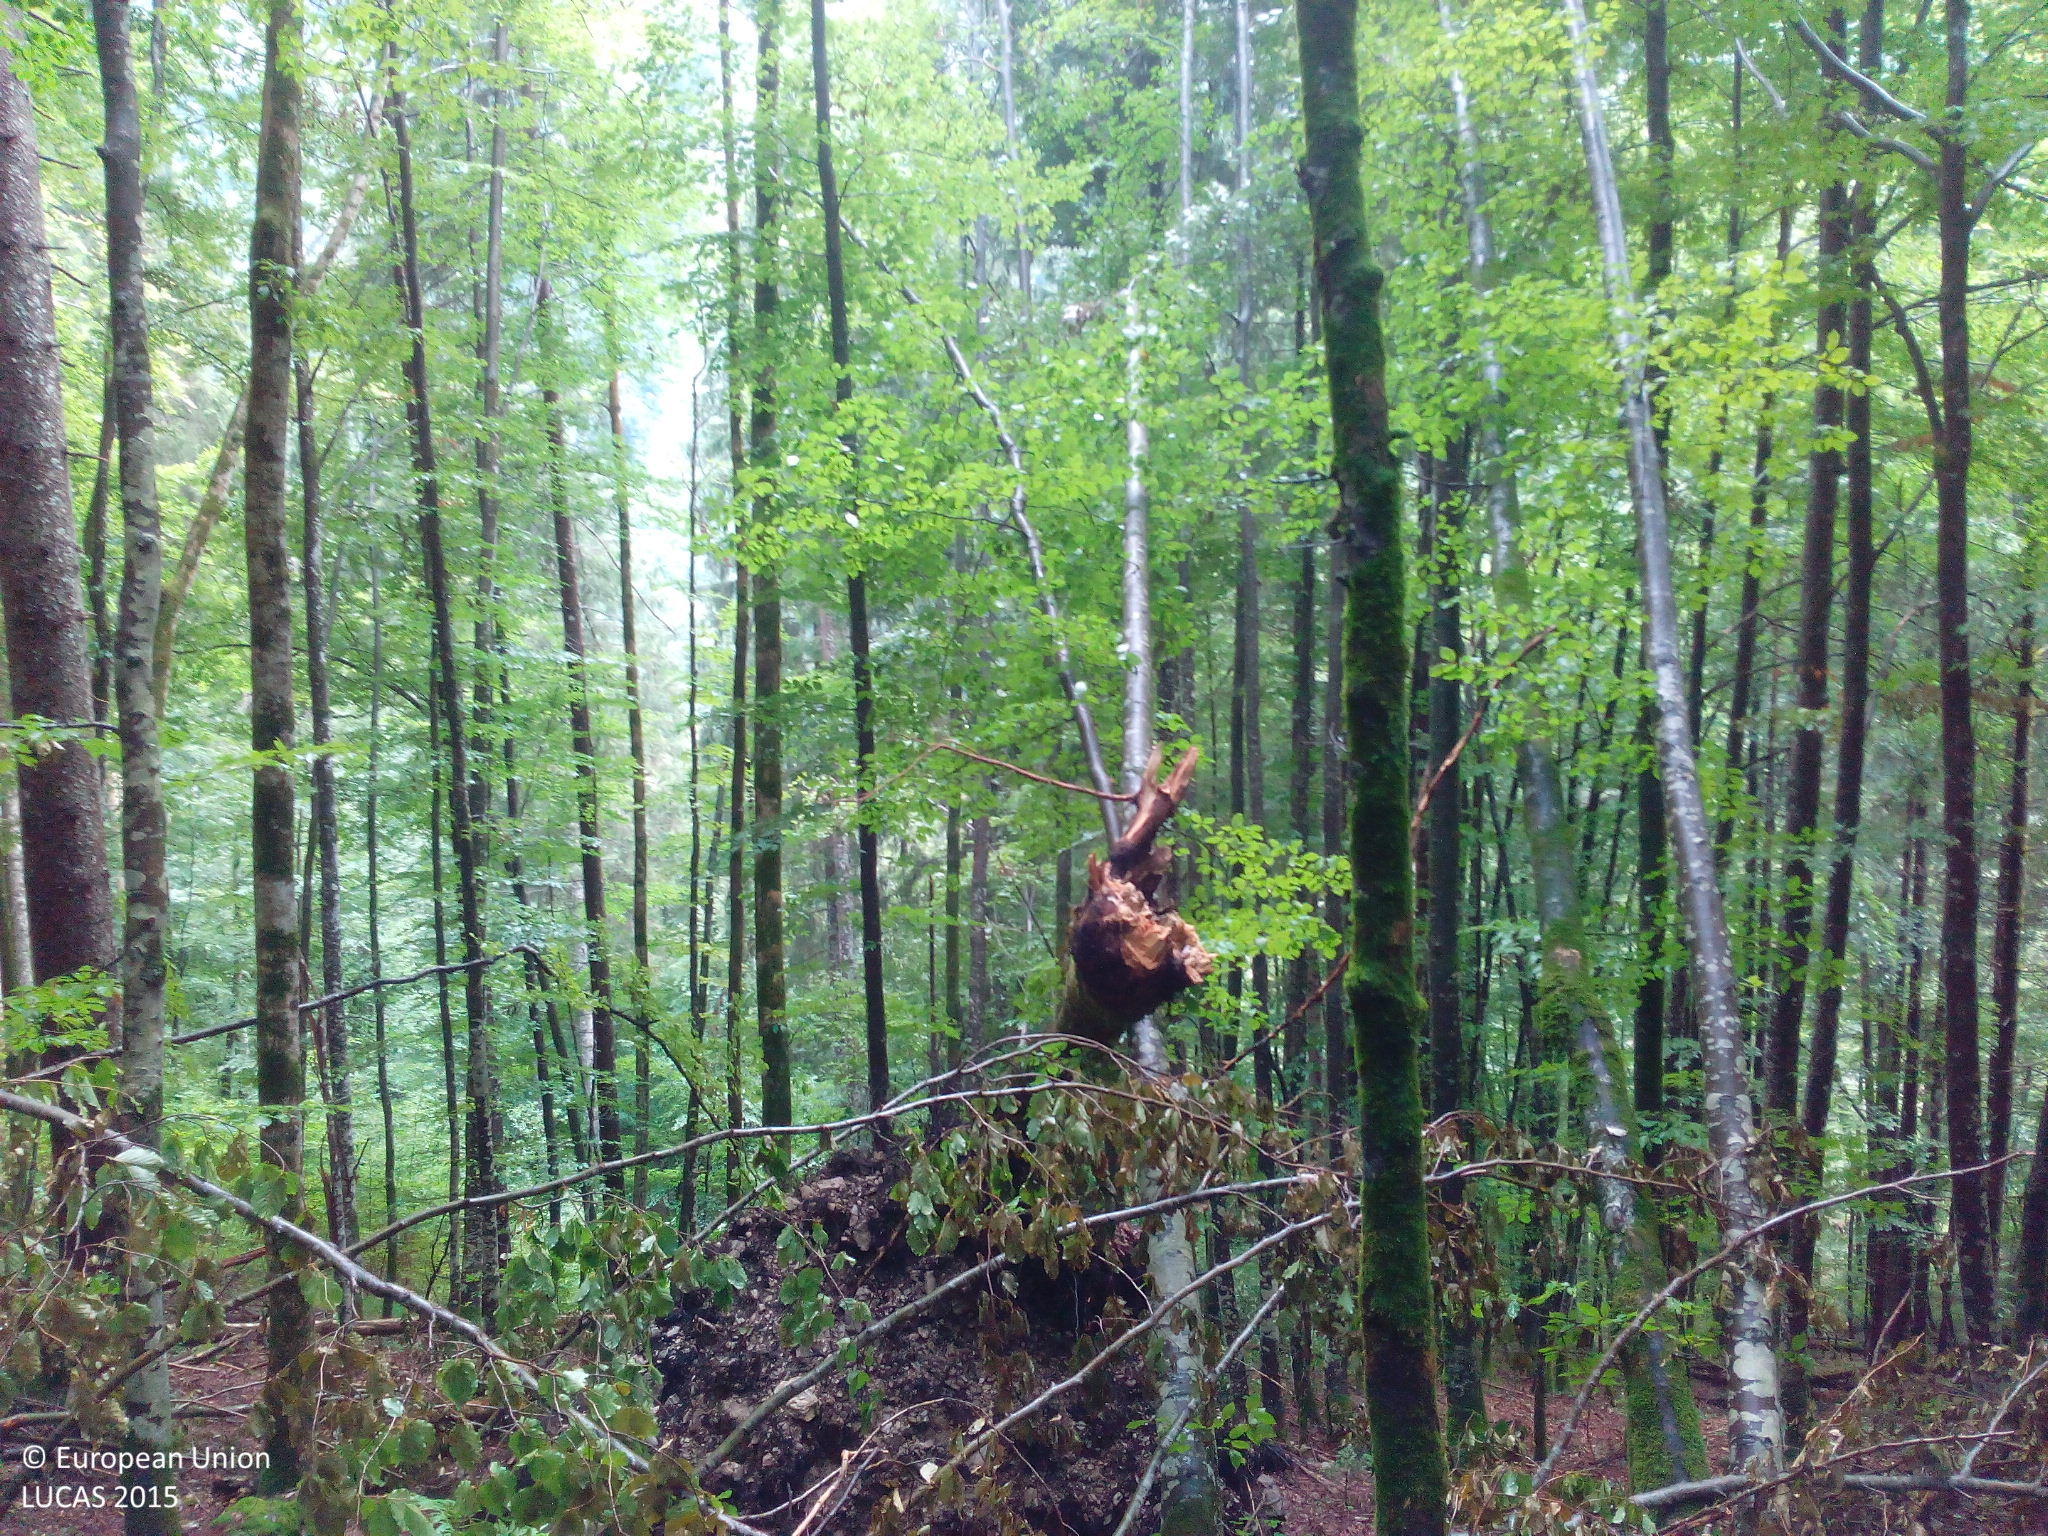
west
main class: Woodland
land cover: Broadleaved woodland
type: mesophytic deciduous forest
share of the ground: > 75 %
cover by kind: broadleaved forest trees 100 %
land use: Forestry
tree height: > 5 m
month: July
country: DE
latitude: 47.3592
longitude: 10.3042
